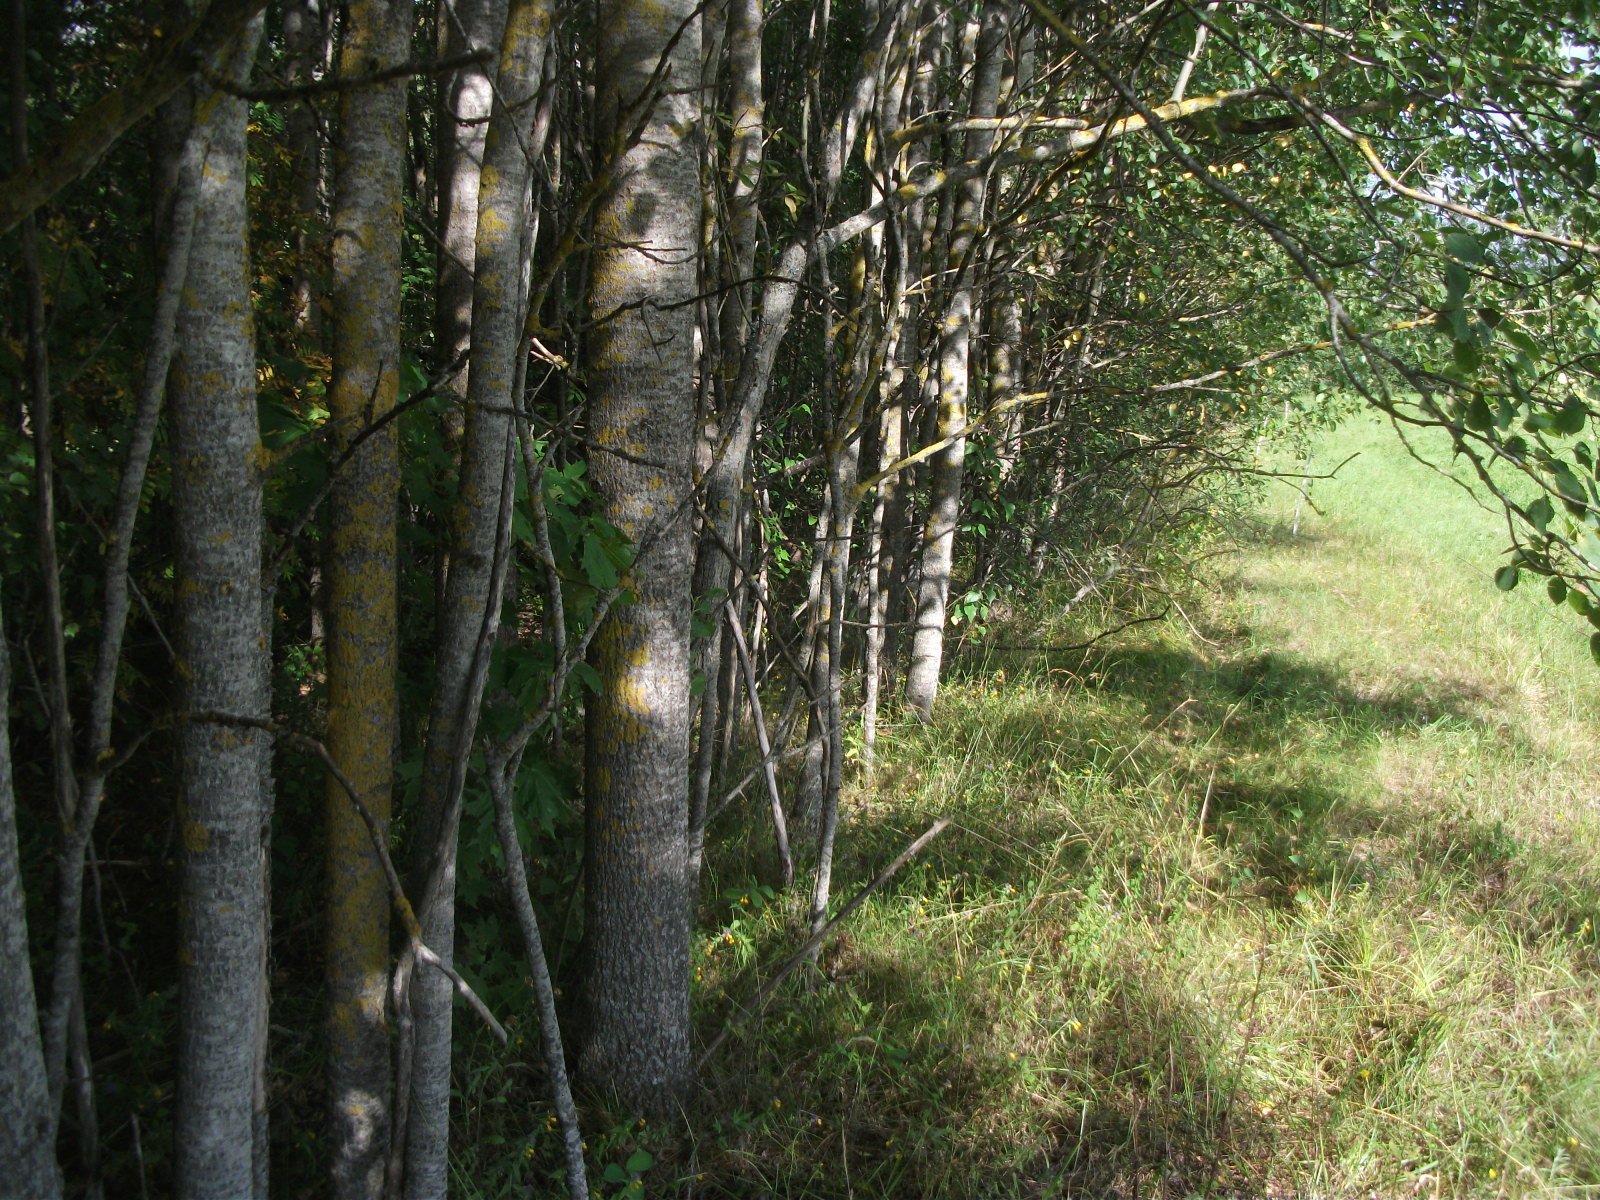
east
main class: Grassland
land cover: Grassland without tree/shrub cover
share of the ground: > 75 %
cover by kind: herbaceous plants 100 %
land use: Agriculture (excluding fallow land and kitchen gardens)
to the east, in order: Grassland without tree/shrub cover; Fences; Broadleaved woodland; Tracks; Broadleaved woodland; Electric lines; Broadleaved woodland; Grass margins; Paved roads, cycling and walking lanes; Grass margins; Single bushes/trees; Grassland without tree/shrub cover; Electric lines; Grassland without tree/shrub cover
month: August
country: LV
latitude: 56.4873
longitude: 26.3677
